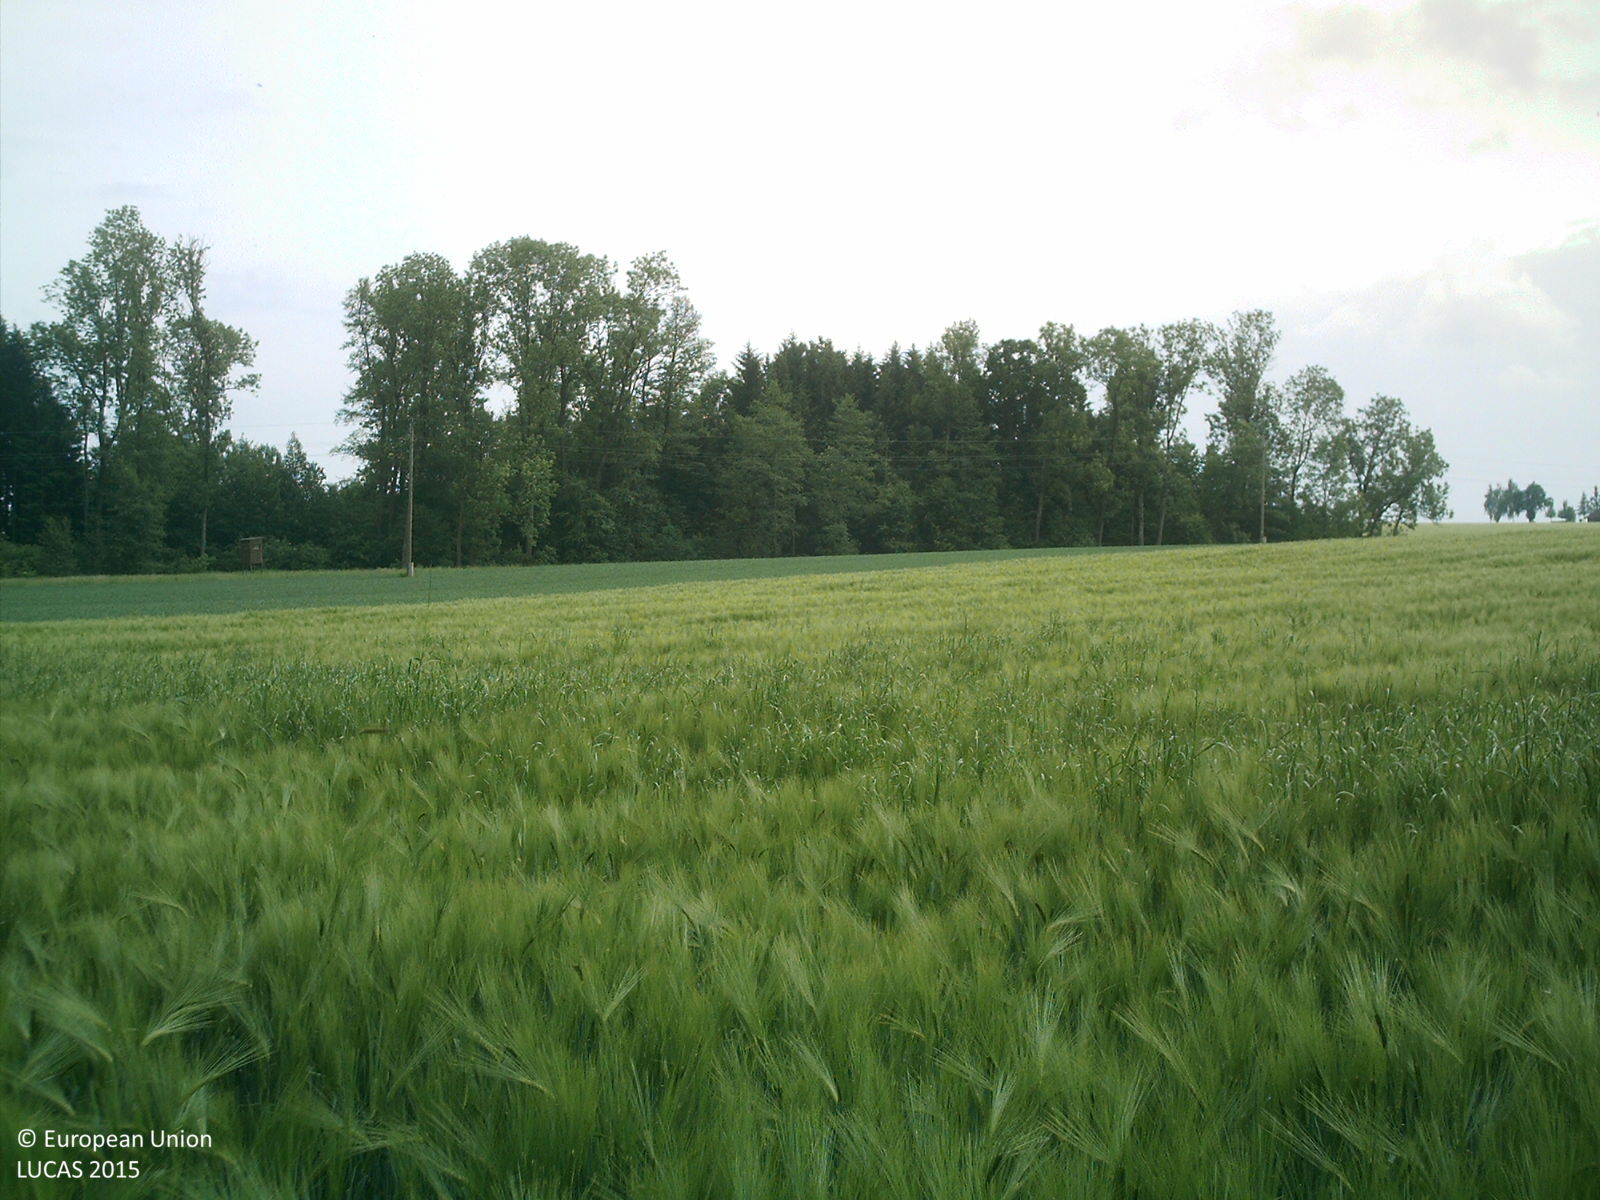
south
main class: Cropland
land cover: Barley
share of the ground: > 75 %
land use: Agriculture (excluding fallow land and kitchen gardens)
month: May
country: AT
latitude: 48.1412
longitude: 14.2601
